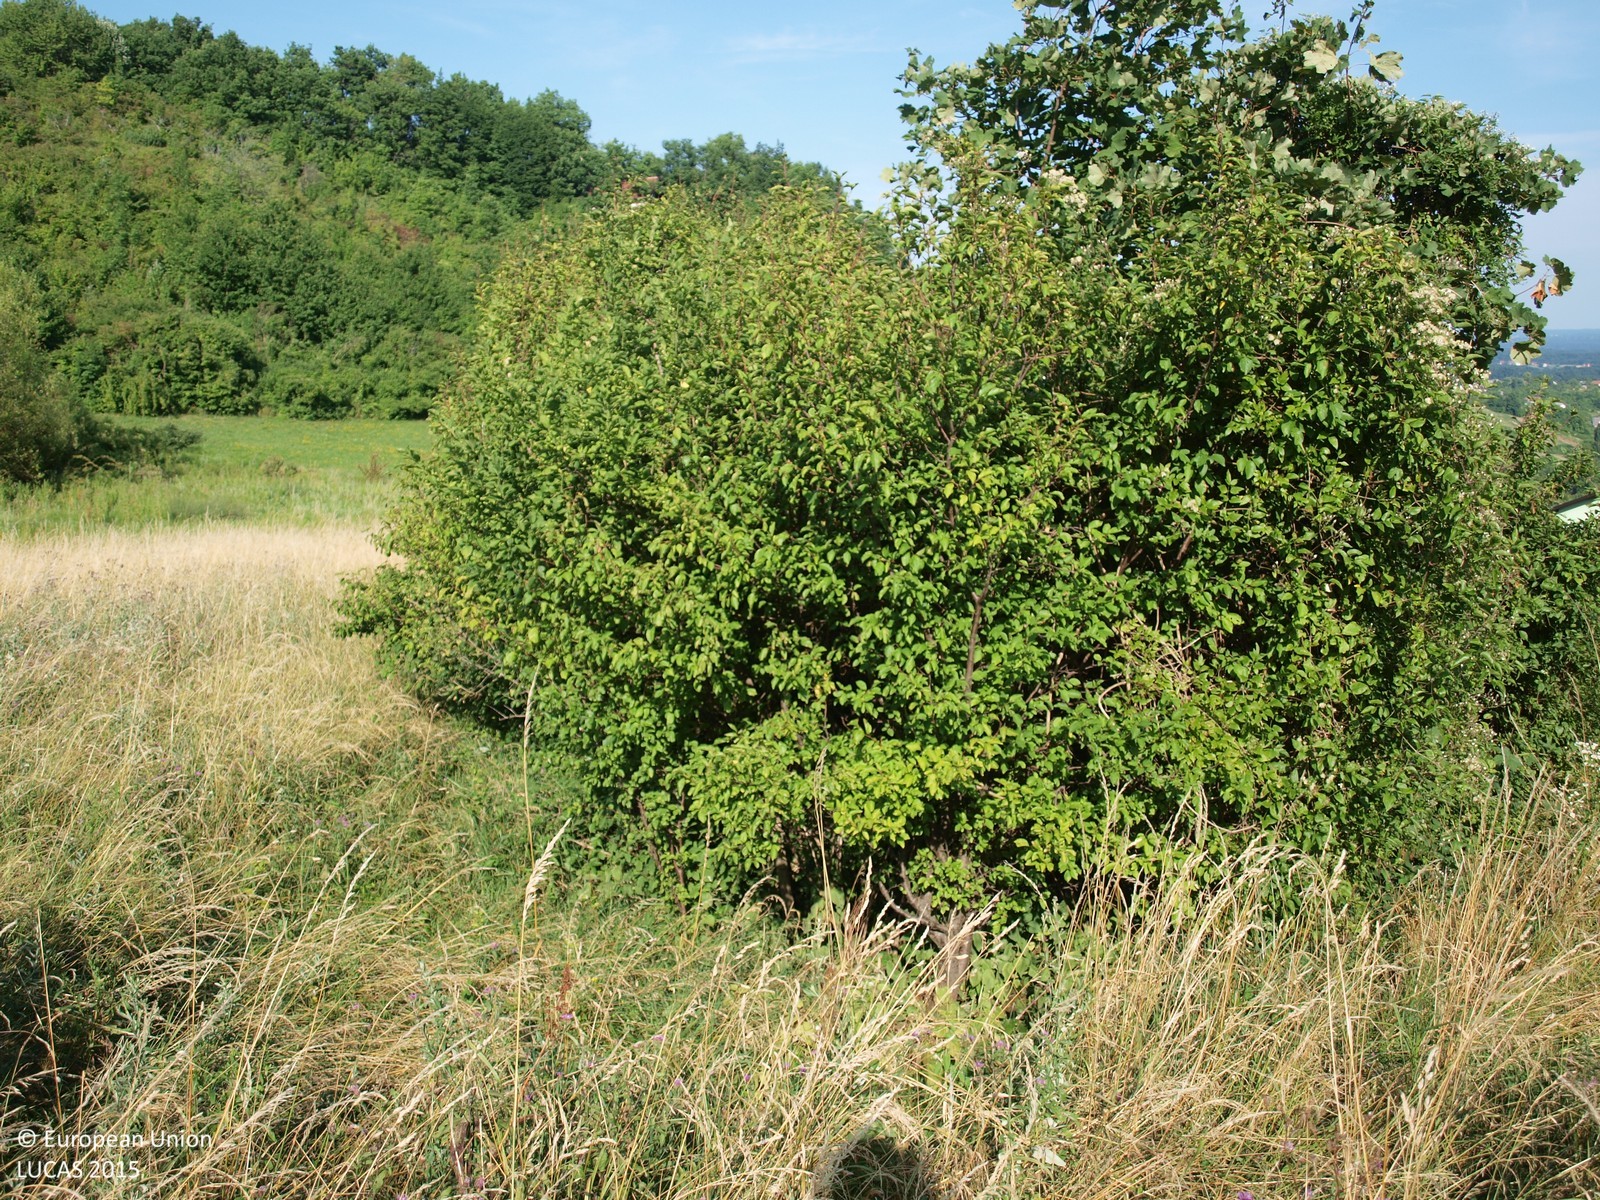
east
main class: Grassland
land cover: Grassland without tree/shrub cover
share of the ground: > 75 %
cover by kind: herbaceous plants 100 %
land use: Agriculture (excluding fallow land and kitchen gardens)
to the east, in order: Grassland without tree/shrub cover; Shrubland with sparse tree cover; Grassland without tree/shrub cover; Shruby margins; Grassland without tree/shrub cover; Broadleaved woodland; Artificial constructions in urban areas
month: July
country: HR
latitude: 45.7303
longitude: 15.6897
